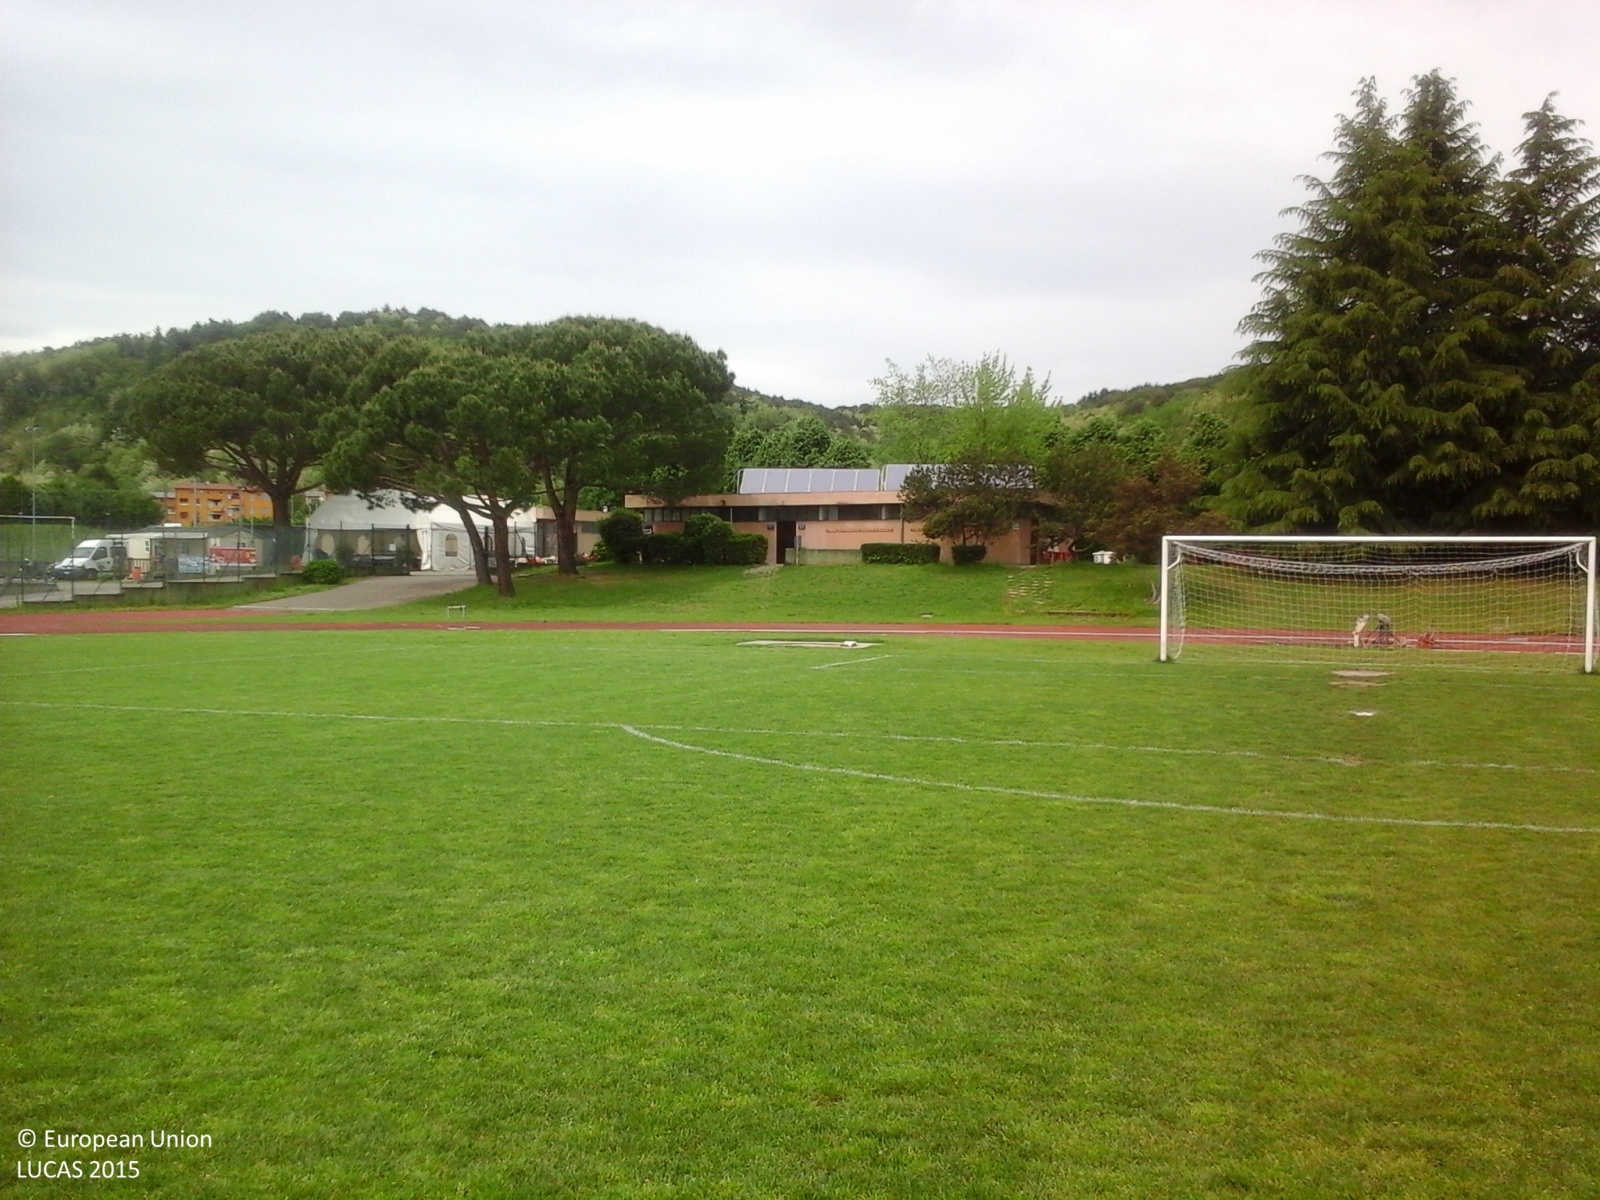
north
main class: Grassland
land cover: Grassland without tree/shrub cover
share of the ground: > 75 %
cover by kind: herbaceous plants 100 %
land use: Sport
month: May
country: IT
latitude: 45.7298
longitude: 8.6272
